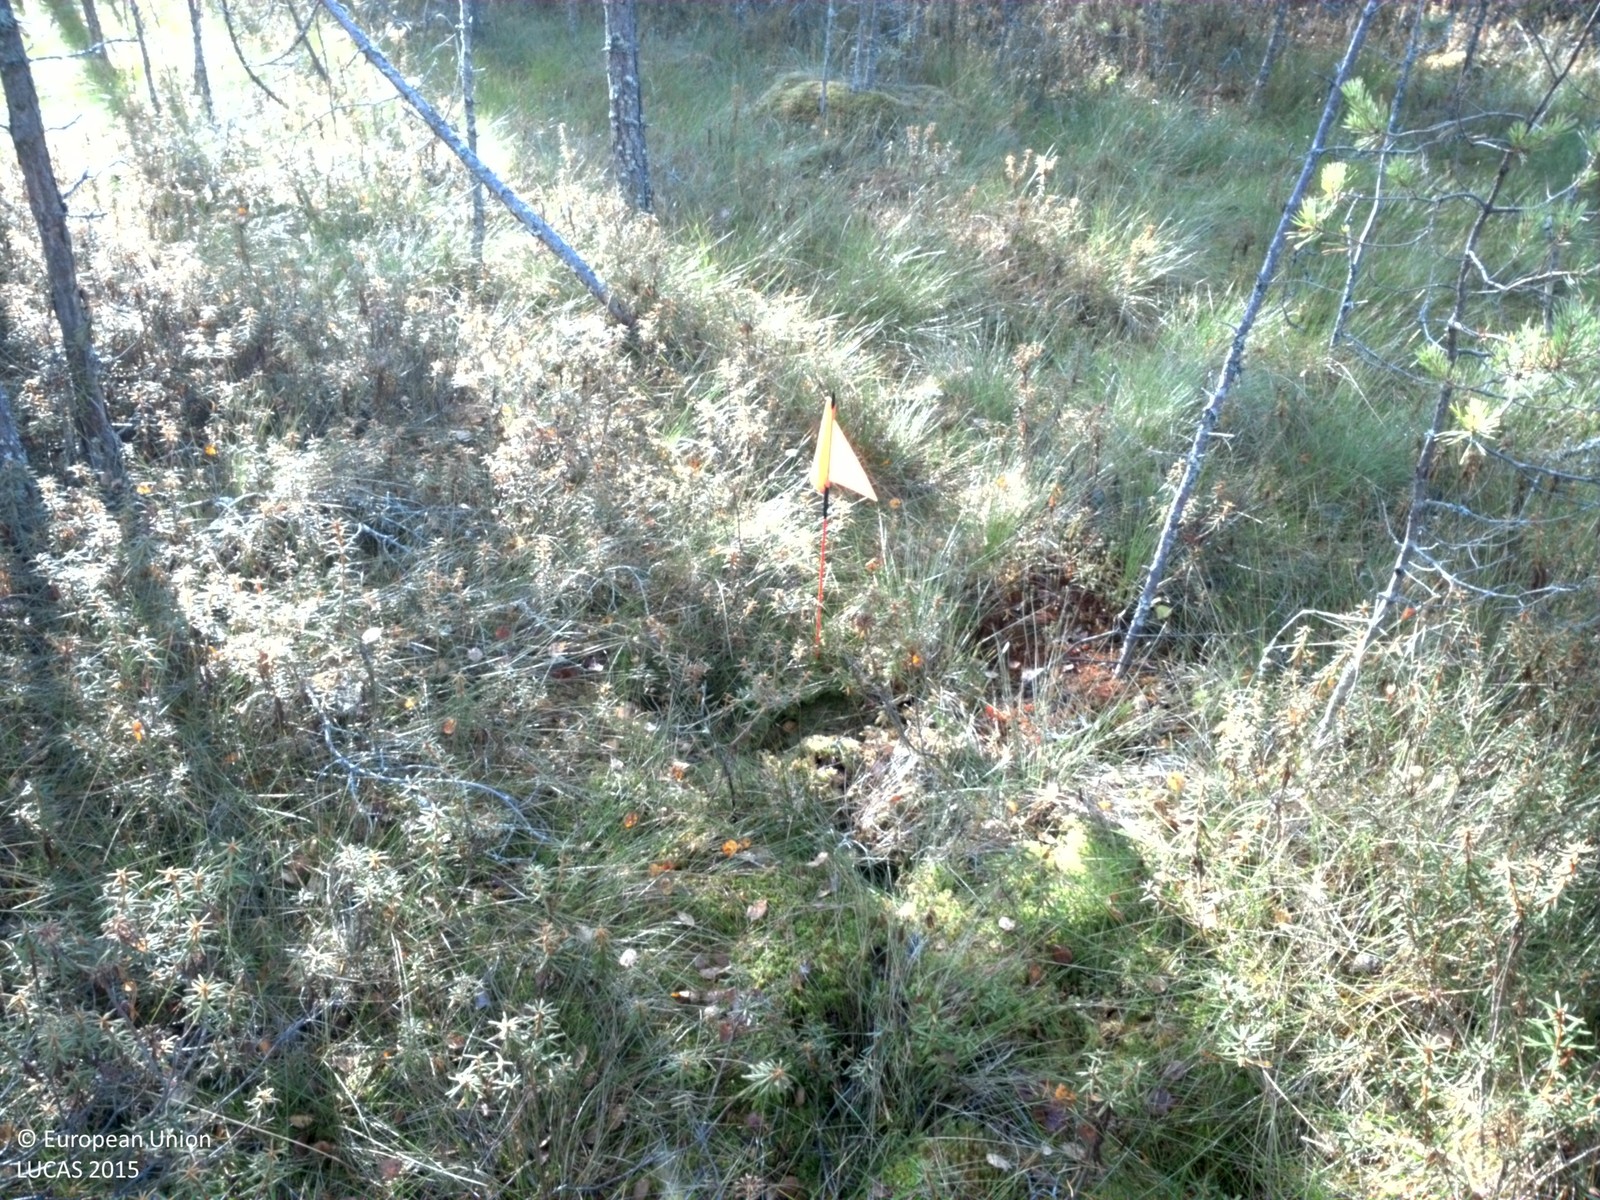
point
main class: Woodland
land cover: Pine dominated coniferous woodland
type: boreal forest
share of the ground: 50 - 75 %
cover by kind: coniferous forest trees 55 %, lichens and mosses 15 %, broadleaved forest trees 10 %, shrubs 10 %, herbaceous plants 10 %
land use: Forestry
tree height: > 5 m
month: September
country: SE
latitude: 59.9964
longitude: 16.4626
